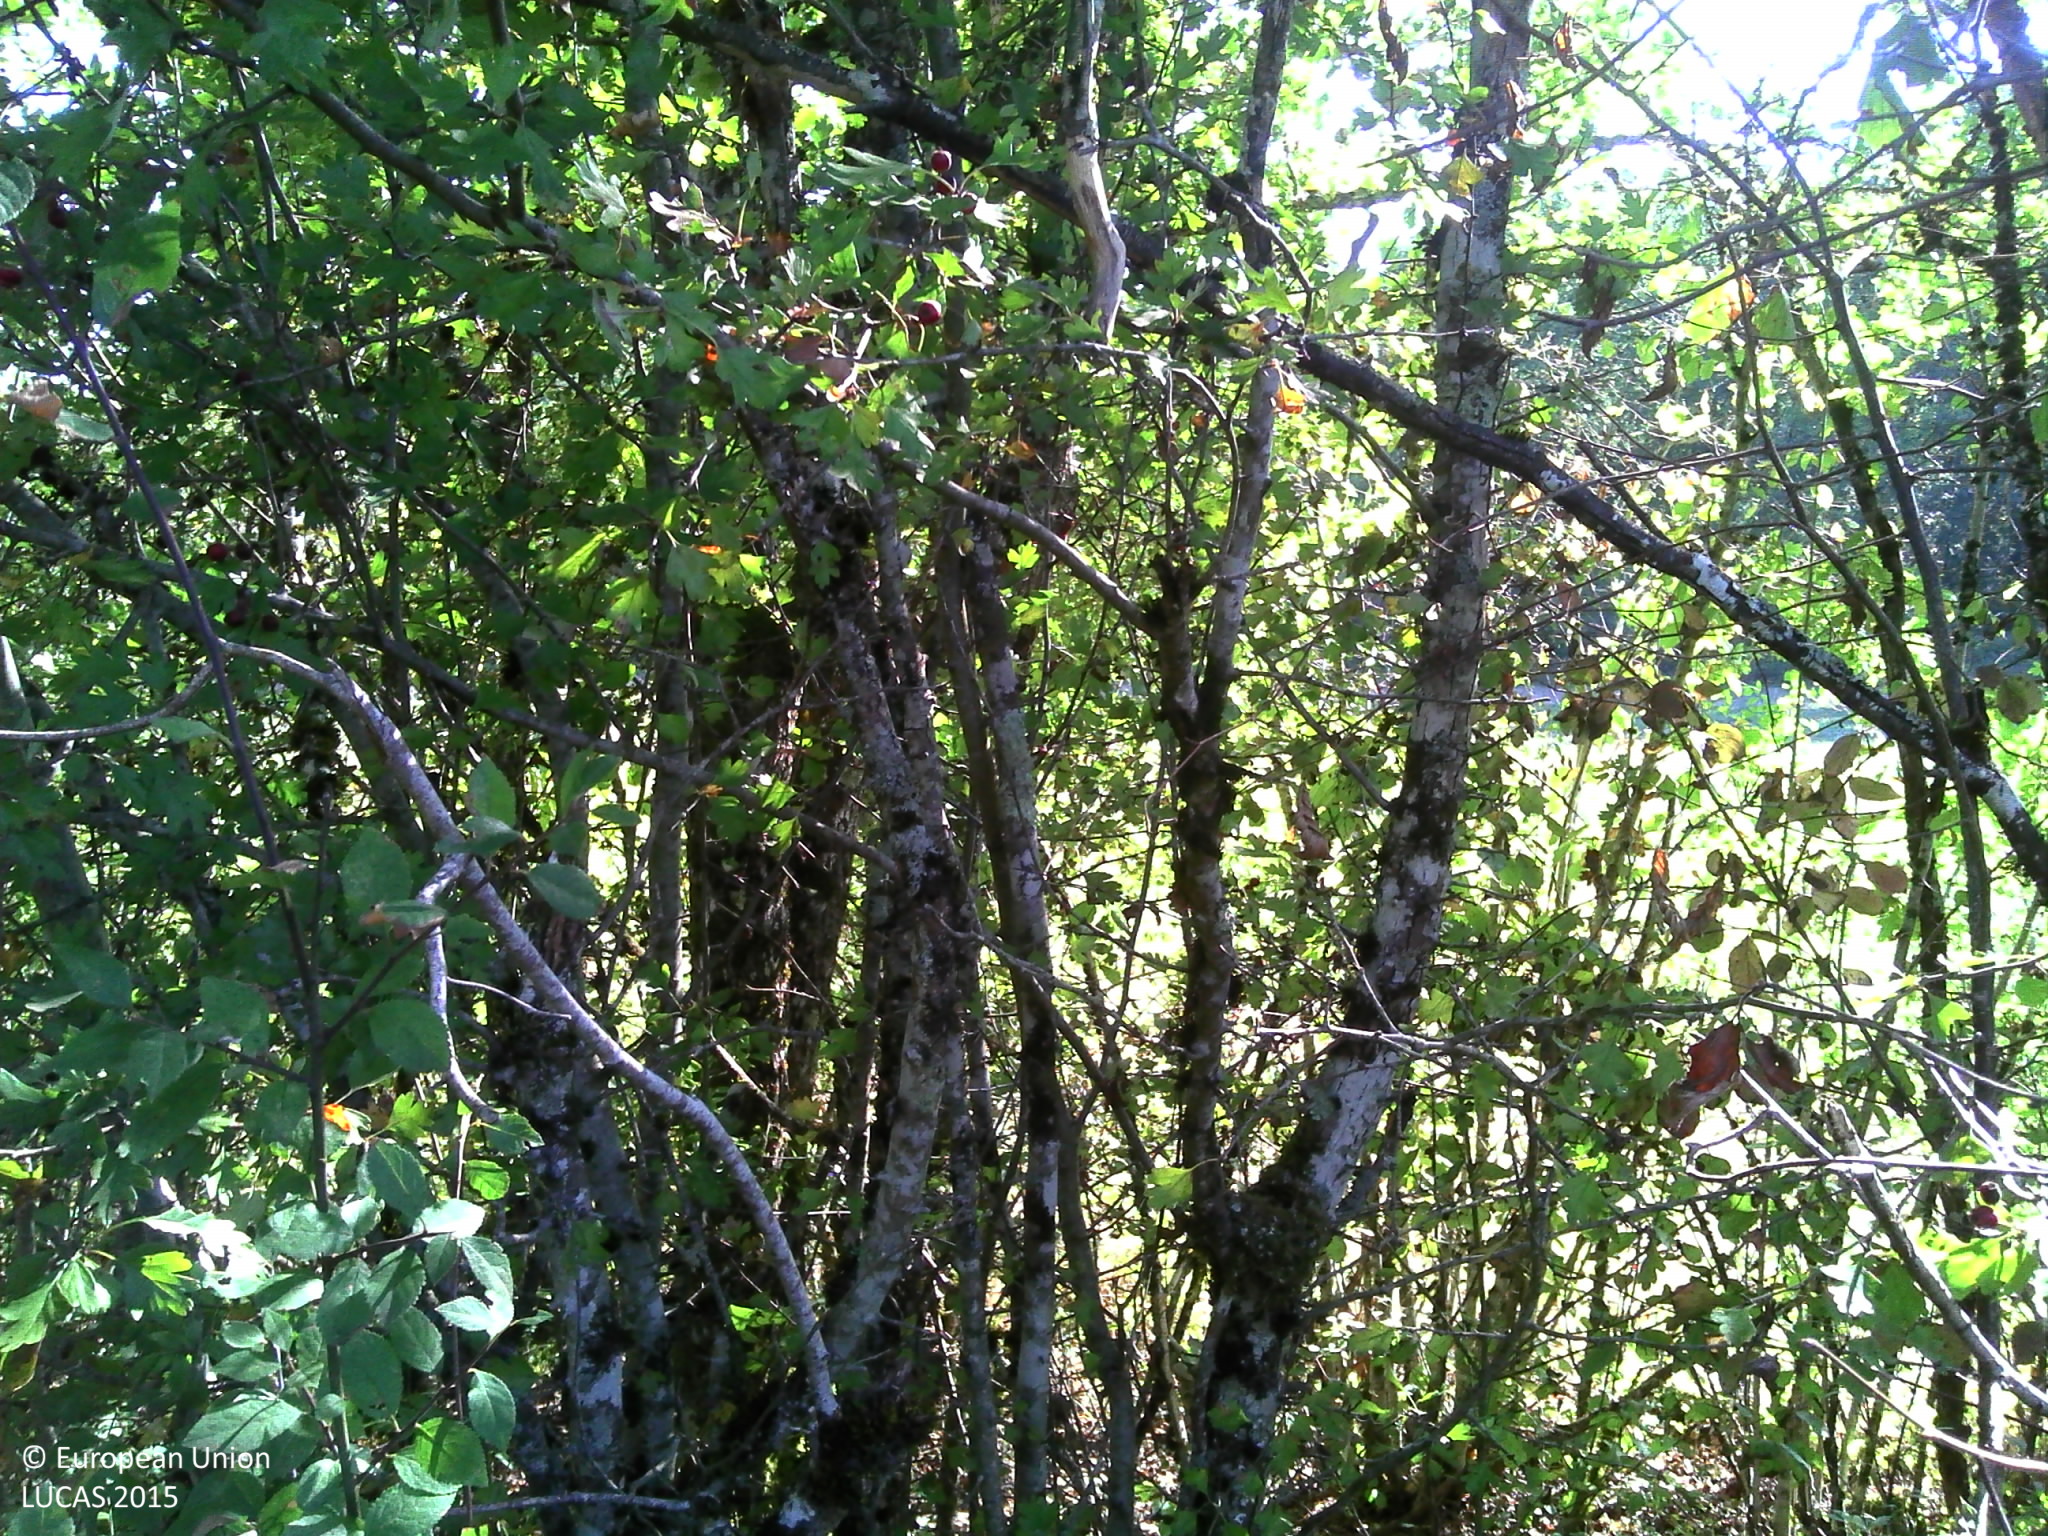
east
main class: Woodland
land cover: Broadleaved woodland
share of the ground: > 75 %
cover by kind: broadleaved forest trees 90 %, herbaceous plants 5 %, lichens and mosses 5 %
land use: Semi-natural and natural areas not in use
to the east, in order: Grass margins; Broadleaved woodland; Rape and turnip rape; Grass margins; Broadleaved woodland; Dry stone walls; Broadleaved woodland; Grassland without tree/shrub cover
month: September
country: FR
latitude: 47.5721
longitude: 4.3222
